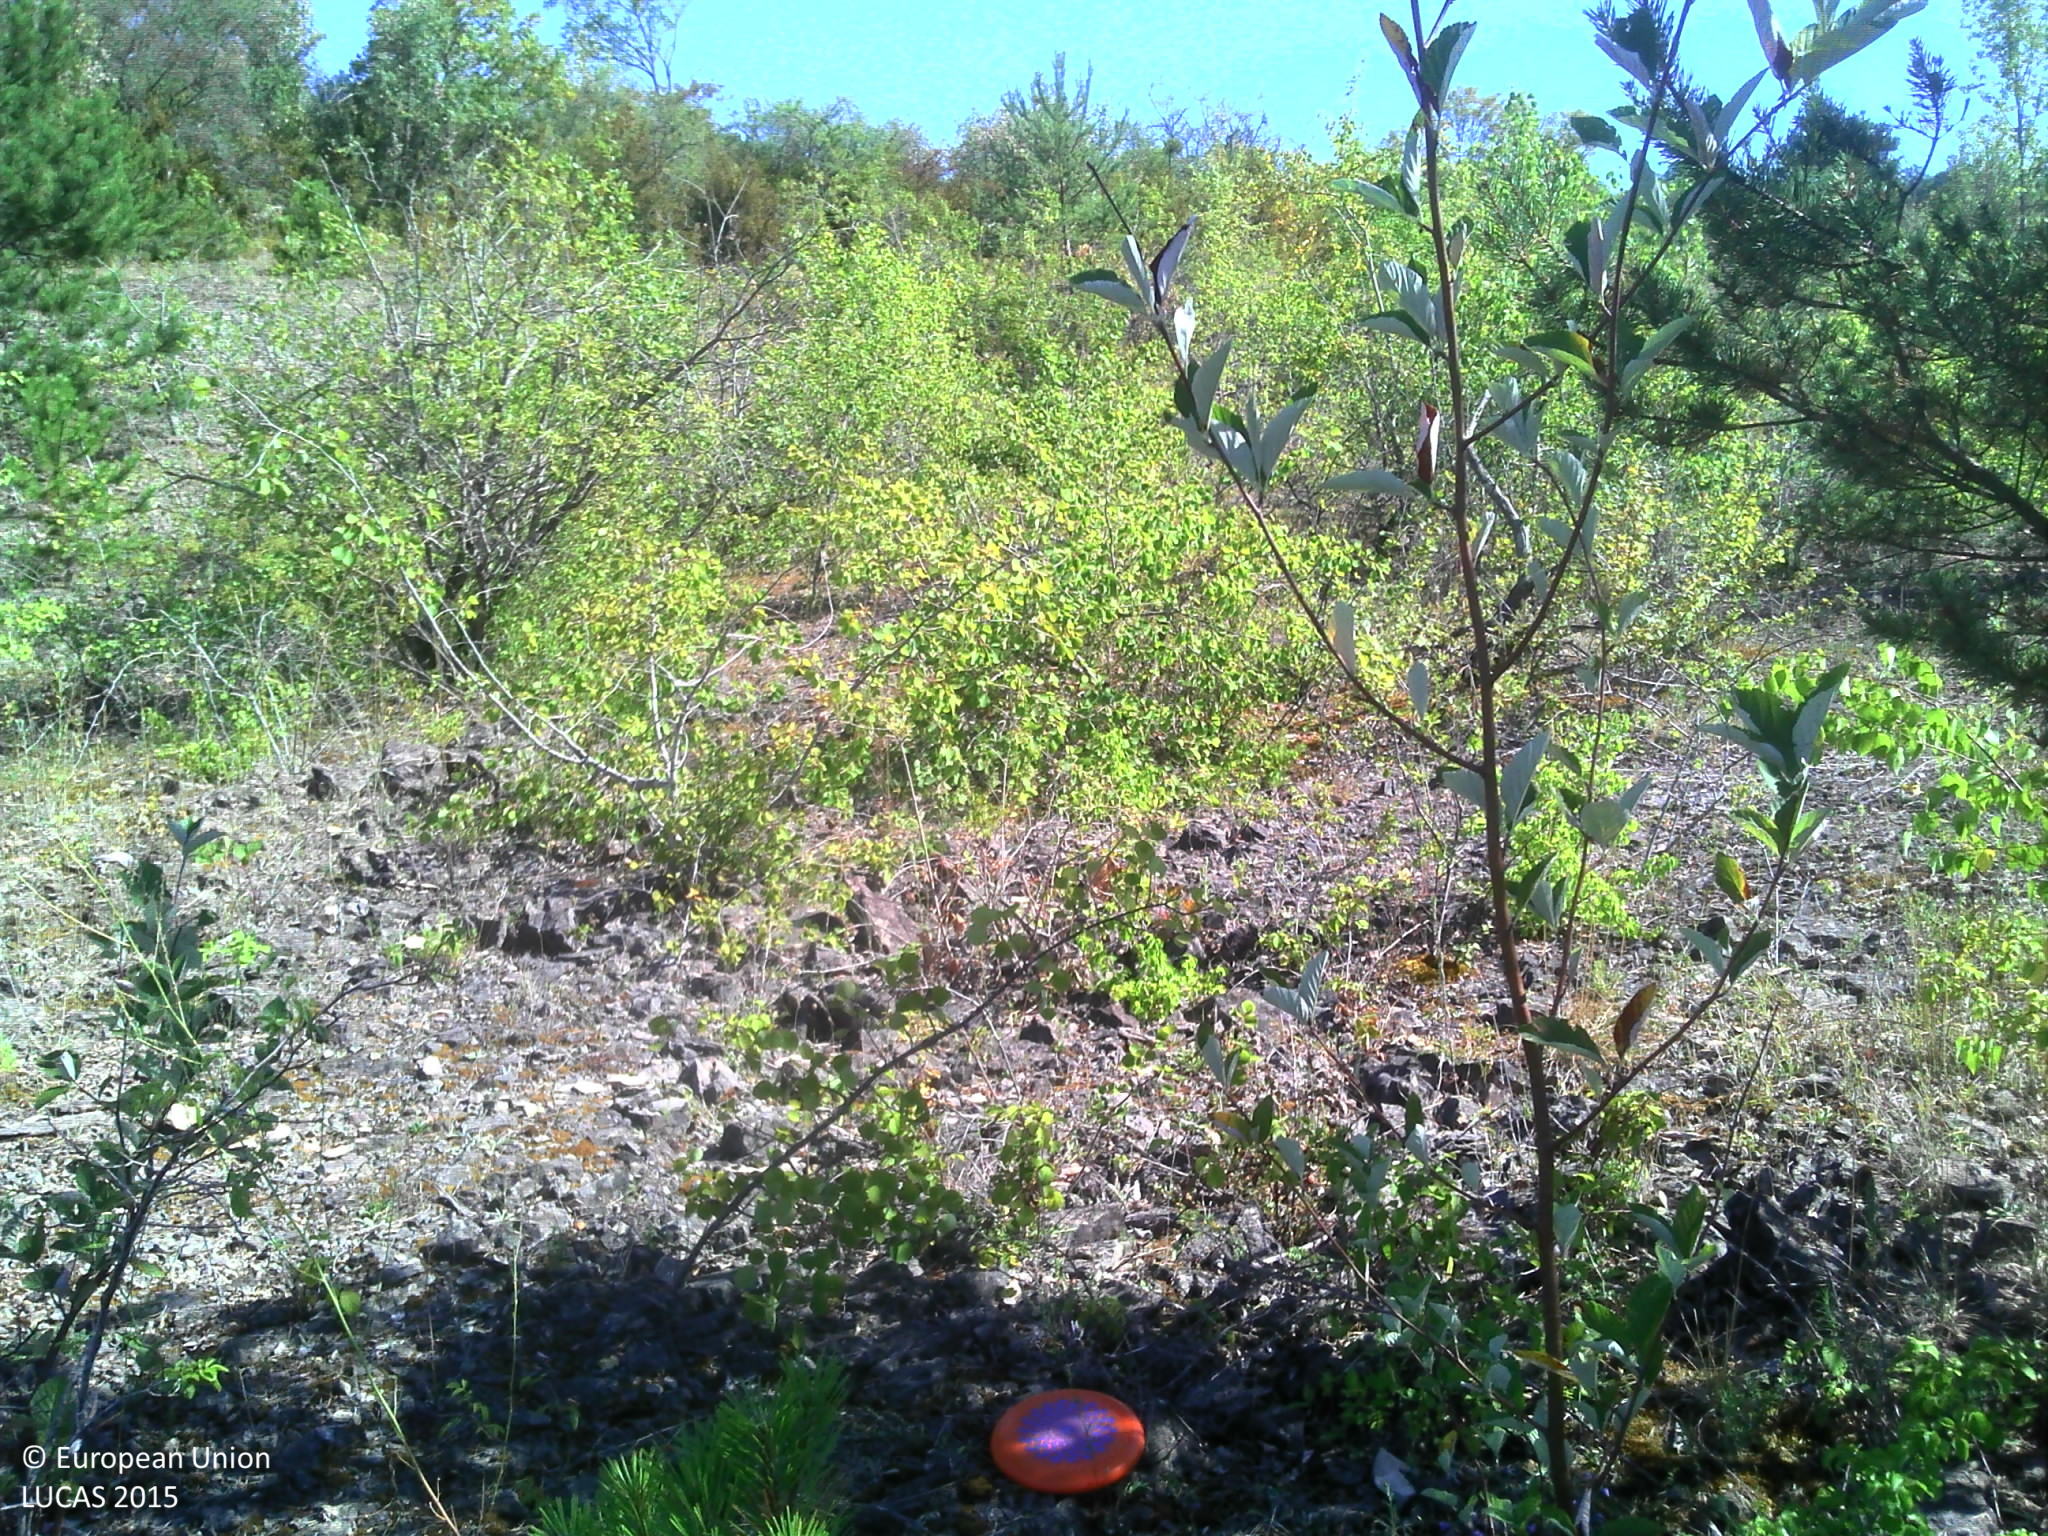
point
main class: Shrubland
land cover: Shrubland with sparse tree cover
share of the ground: > 75 %
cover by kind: shrubs 45 %, unconsolidated bare surface 30 %, herbaceous plants 20 %, broadleaved forest trees 5 %
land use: Semi-natural and natural areas not in use
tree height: < 5 m
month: July
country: FR
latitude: 46.8535
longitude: 4.7417
